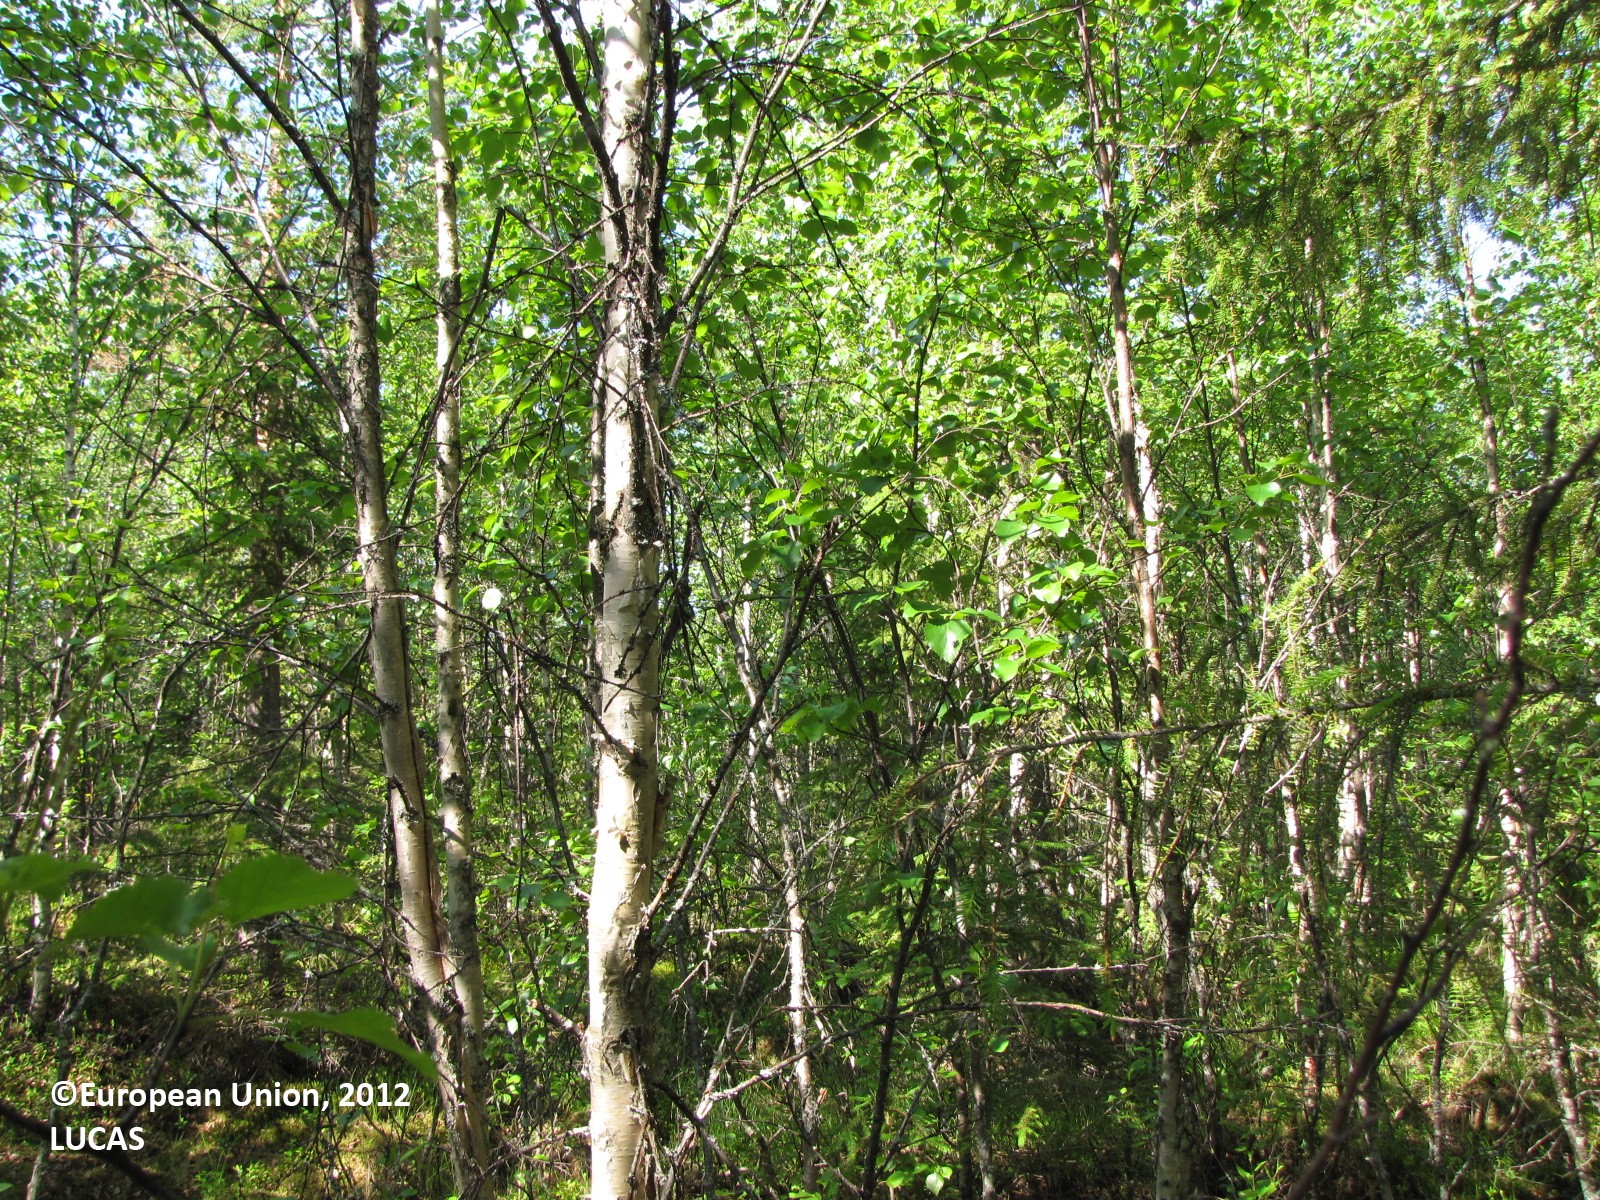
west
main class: Woodland
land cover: Other mixed woodland
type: boreal forest
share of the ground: > 75 %
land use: Forestry
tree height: > 5 m
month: July
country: FI
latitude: 66.2922
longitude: 25.3309
